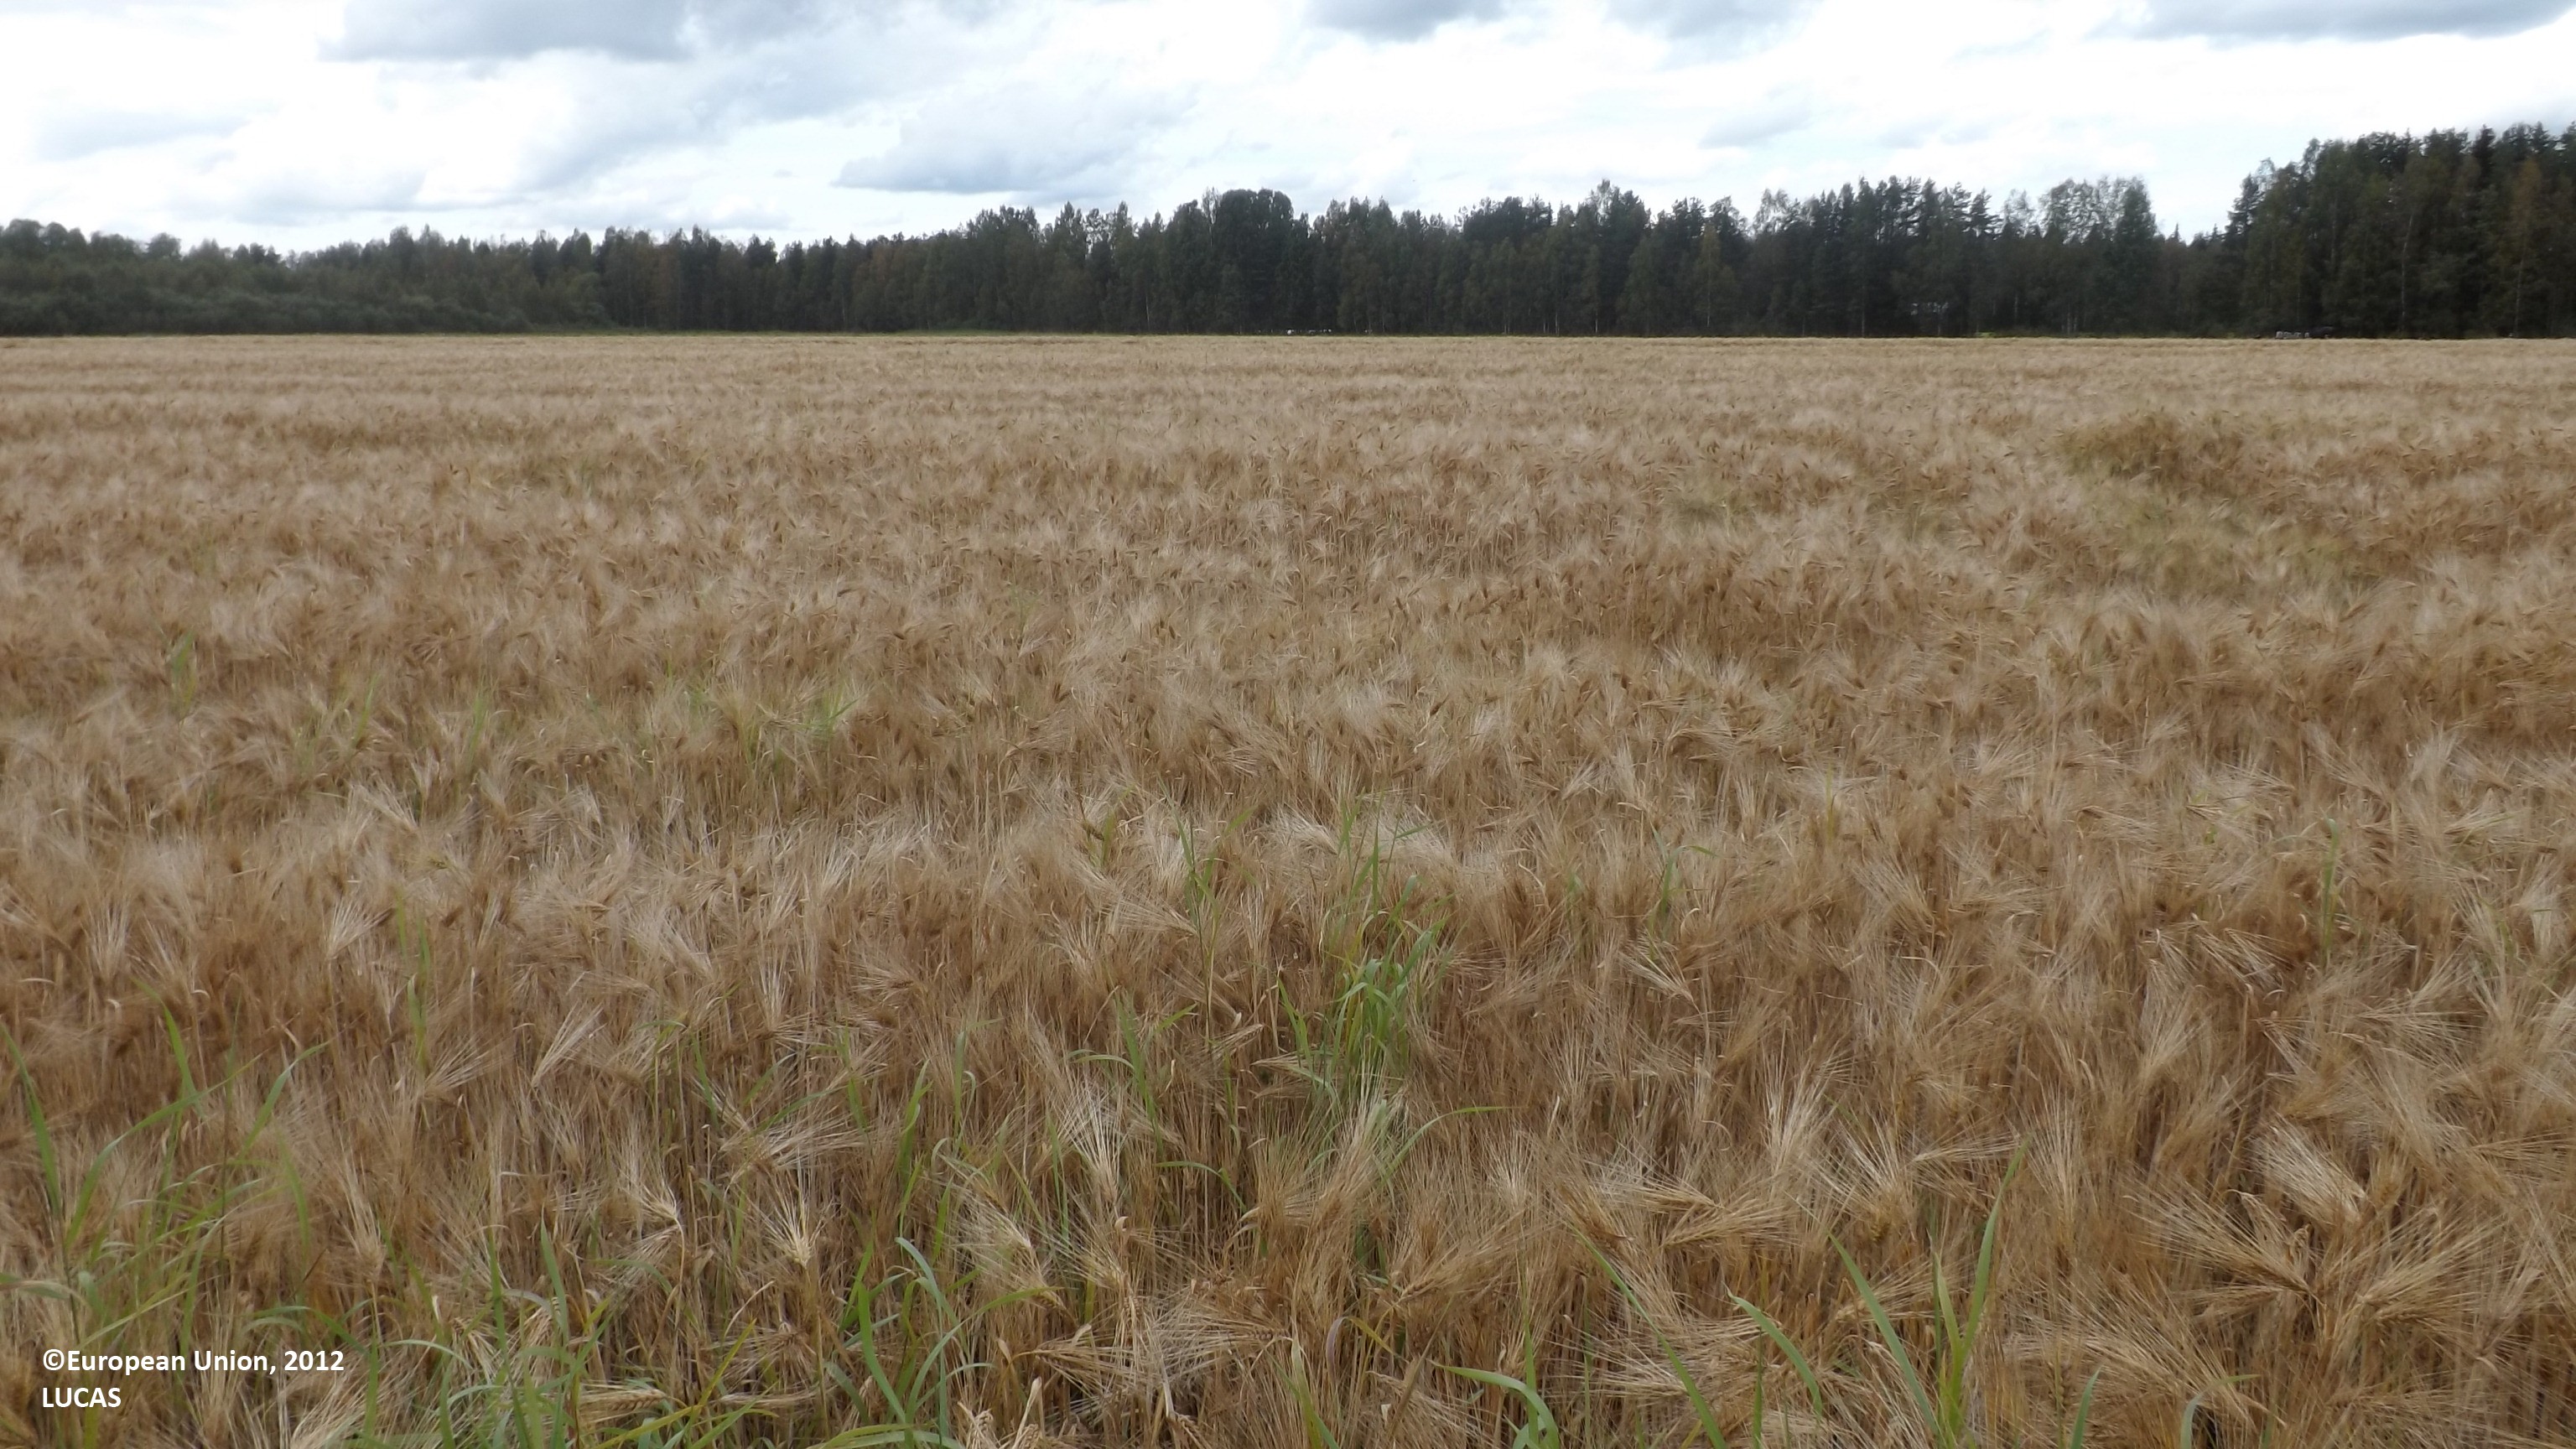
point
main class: Cropland
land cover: Barley
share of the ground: > 75 %
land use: Agriculture (excluding fallow land and kitchen gardens)
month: August
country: FI
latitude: 63.9039
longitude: 23.9829
